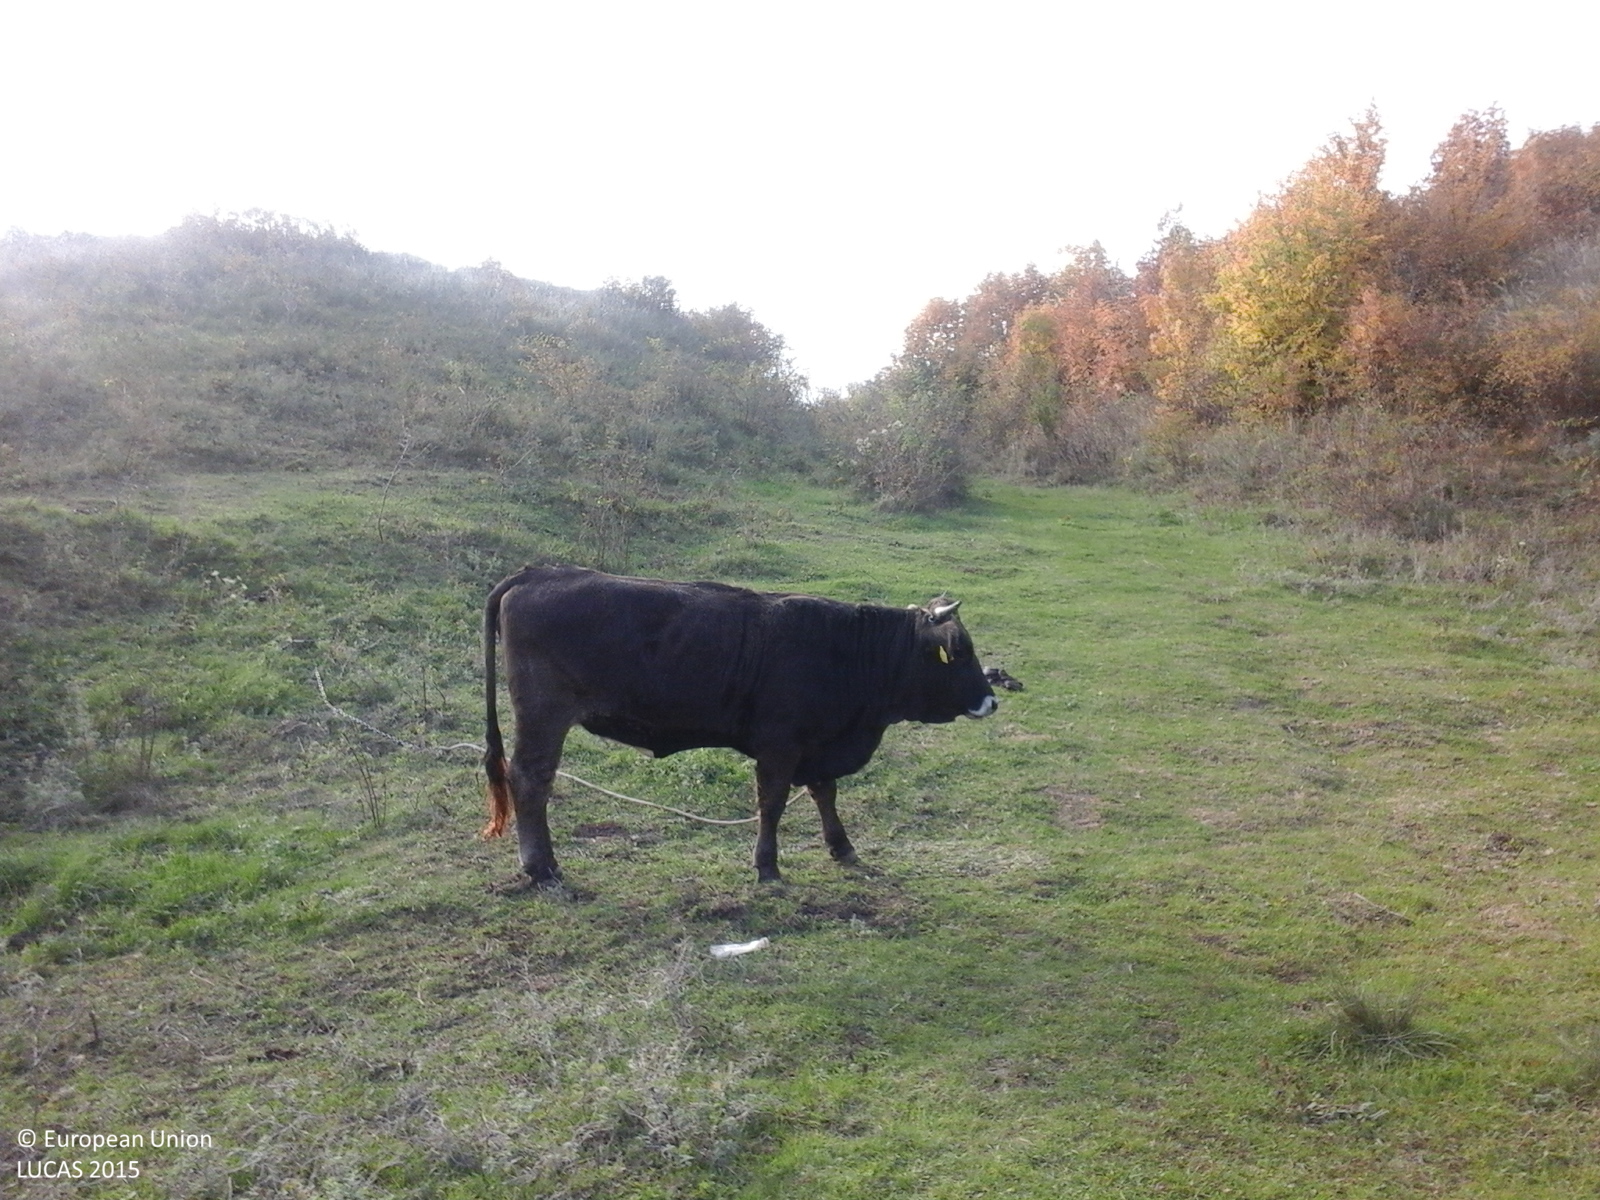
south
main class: Grassland
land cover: Grassland without tree/shrub cover
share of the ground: > 75 %
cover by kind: herbaceous plants 100 %
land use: Agriculture (excluding fallow land and kitchen gardens)
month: October
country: RO
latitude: 45.4414
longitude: 26.9749
